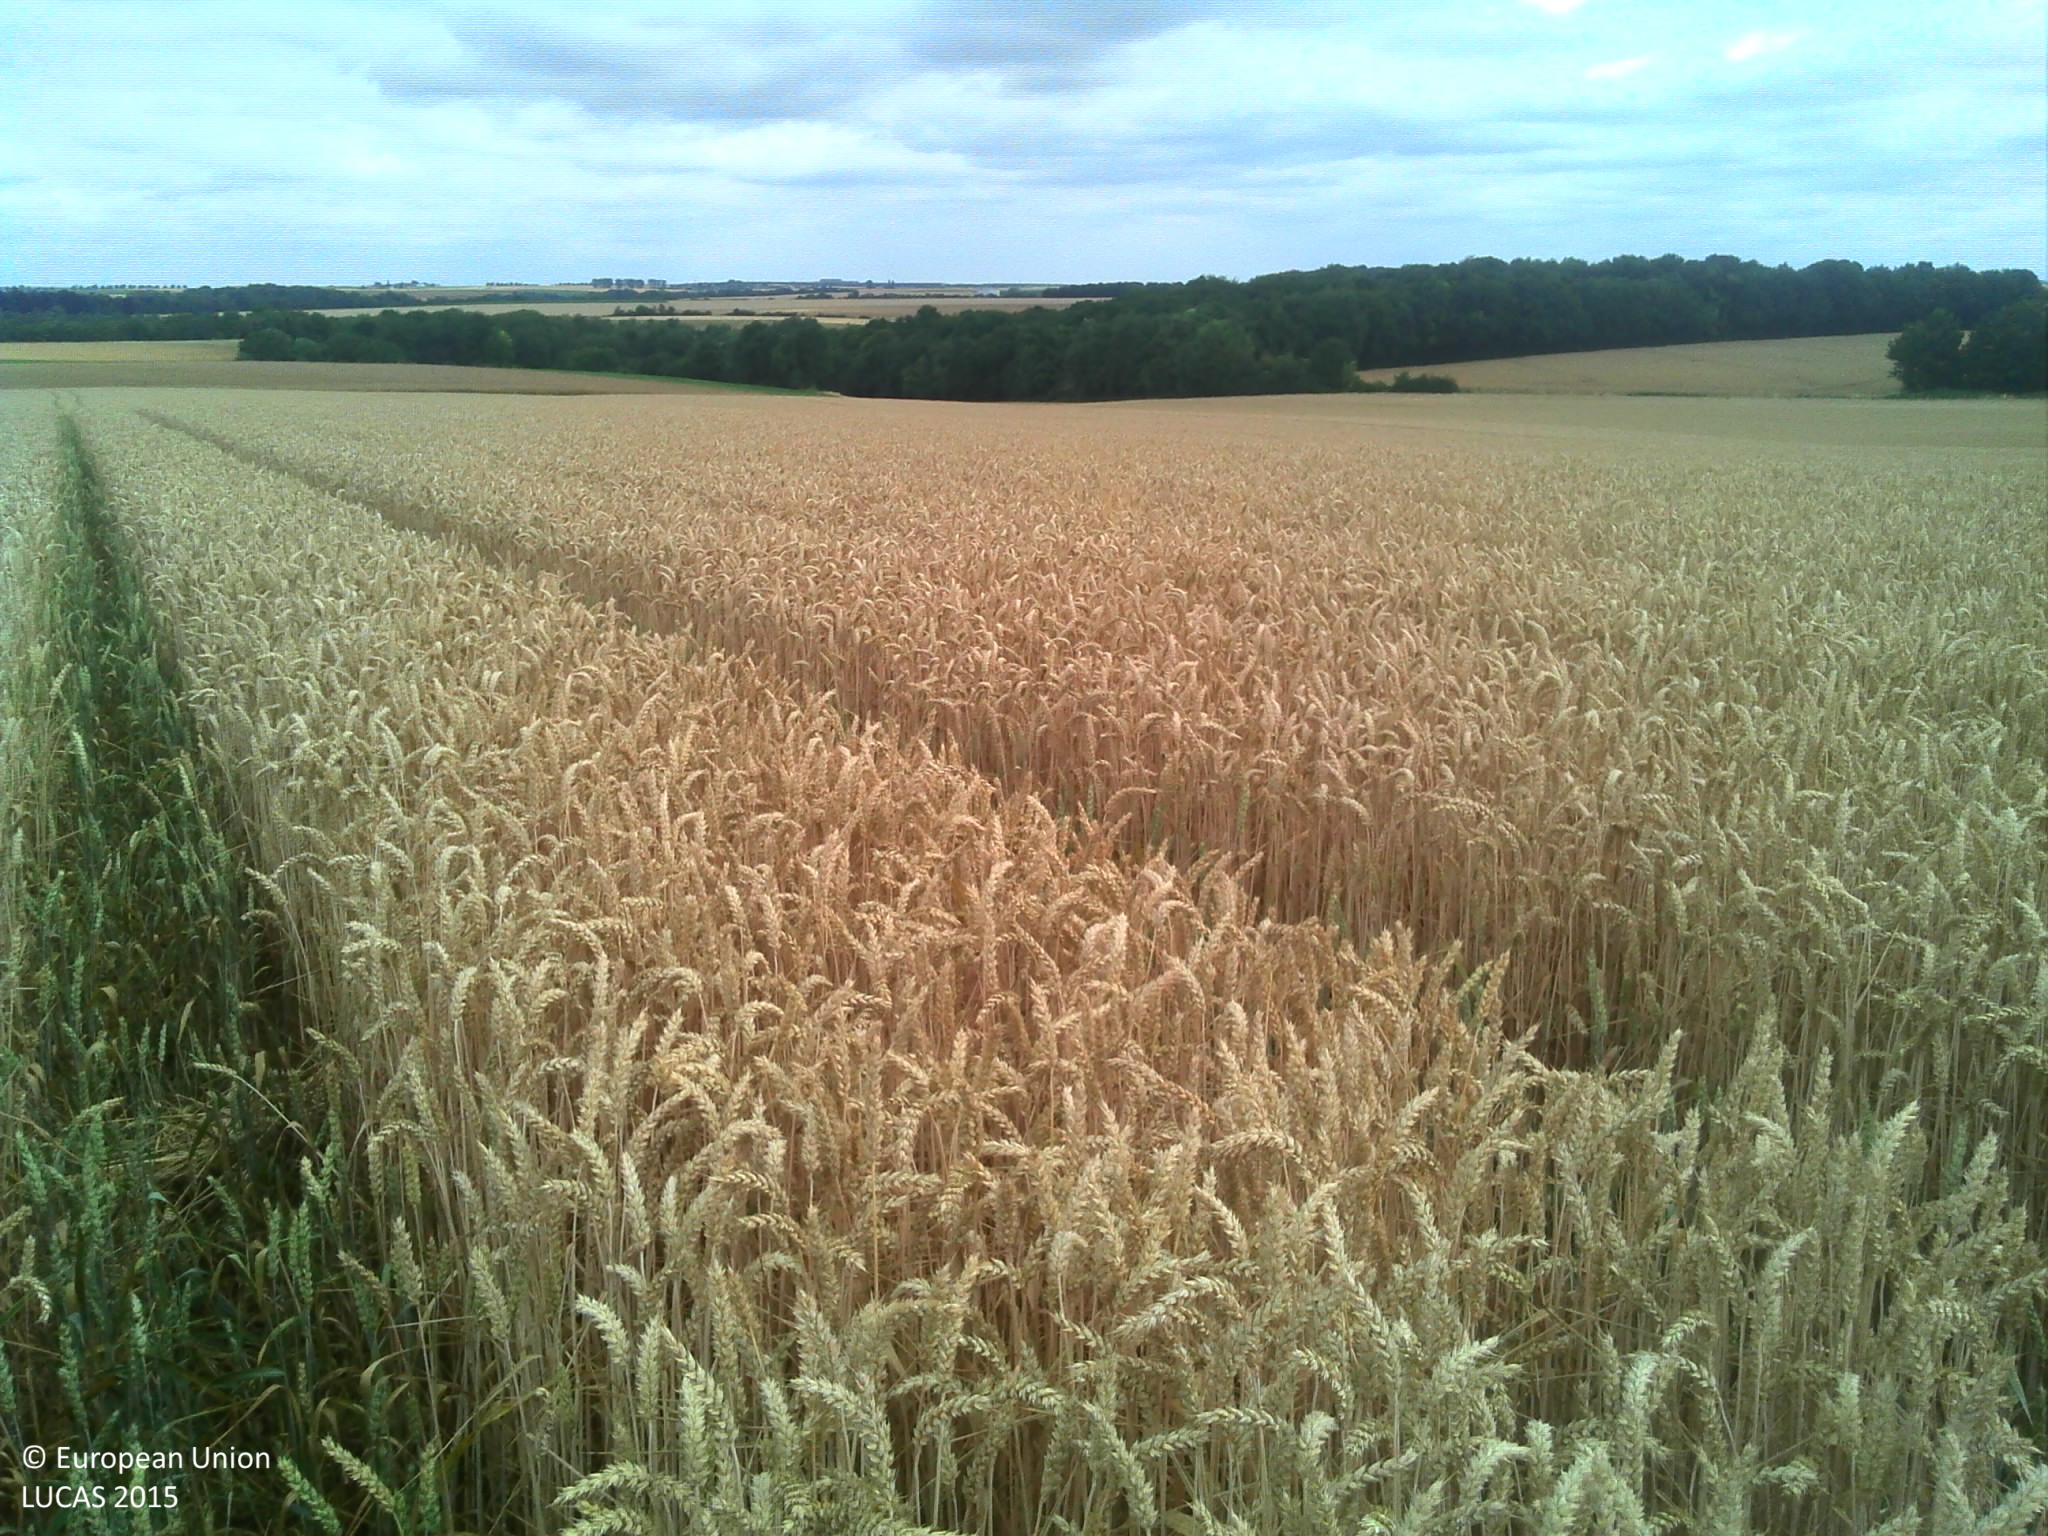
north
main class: Cropland
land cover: Common wheat
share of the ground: > 75 %
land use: Agriculture (excluding fallow land and kitchen gardens)
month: July
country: FR
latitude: 49.2636
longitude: 3.2724
